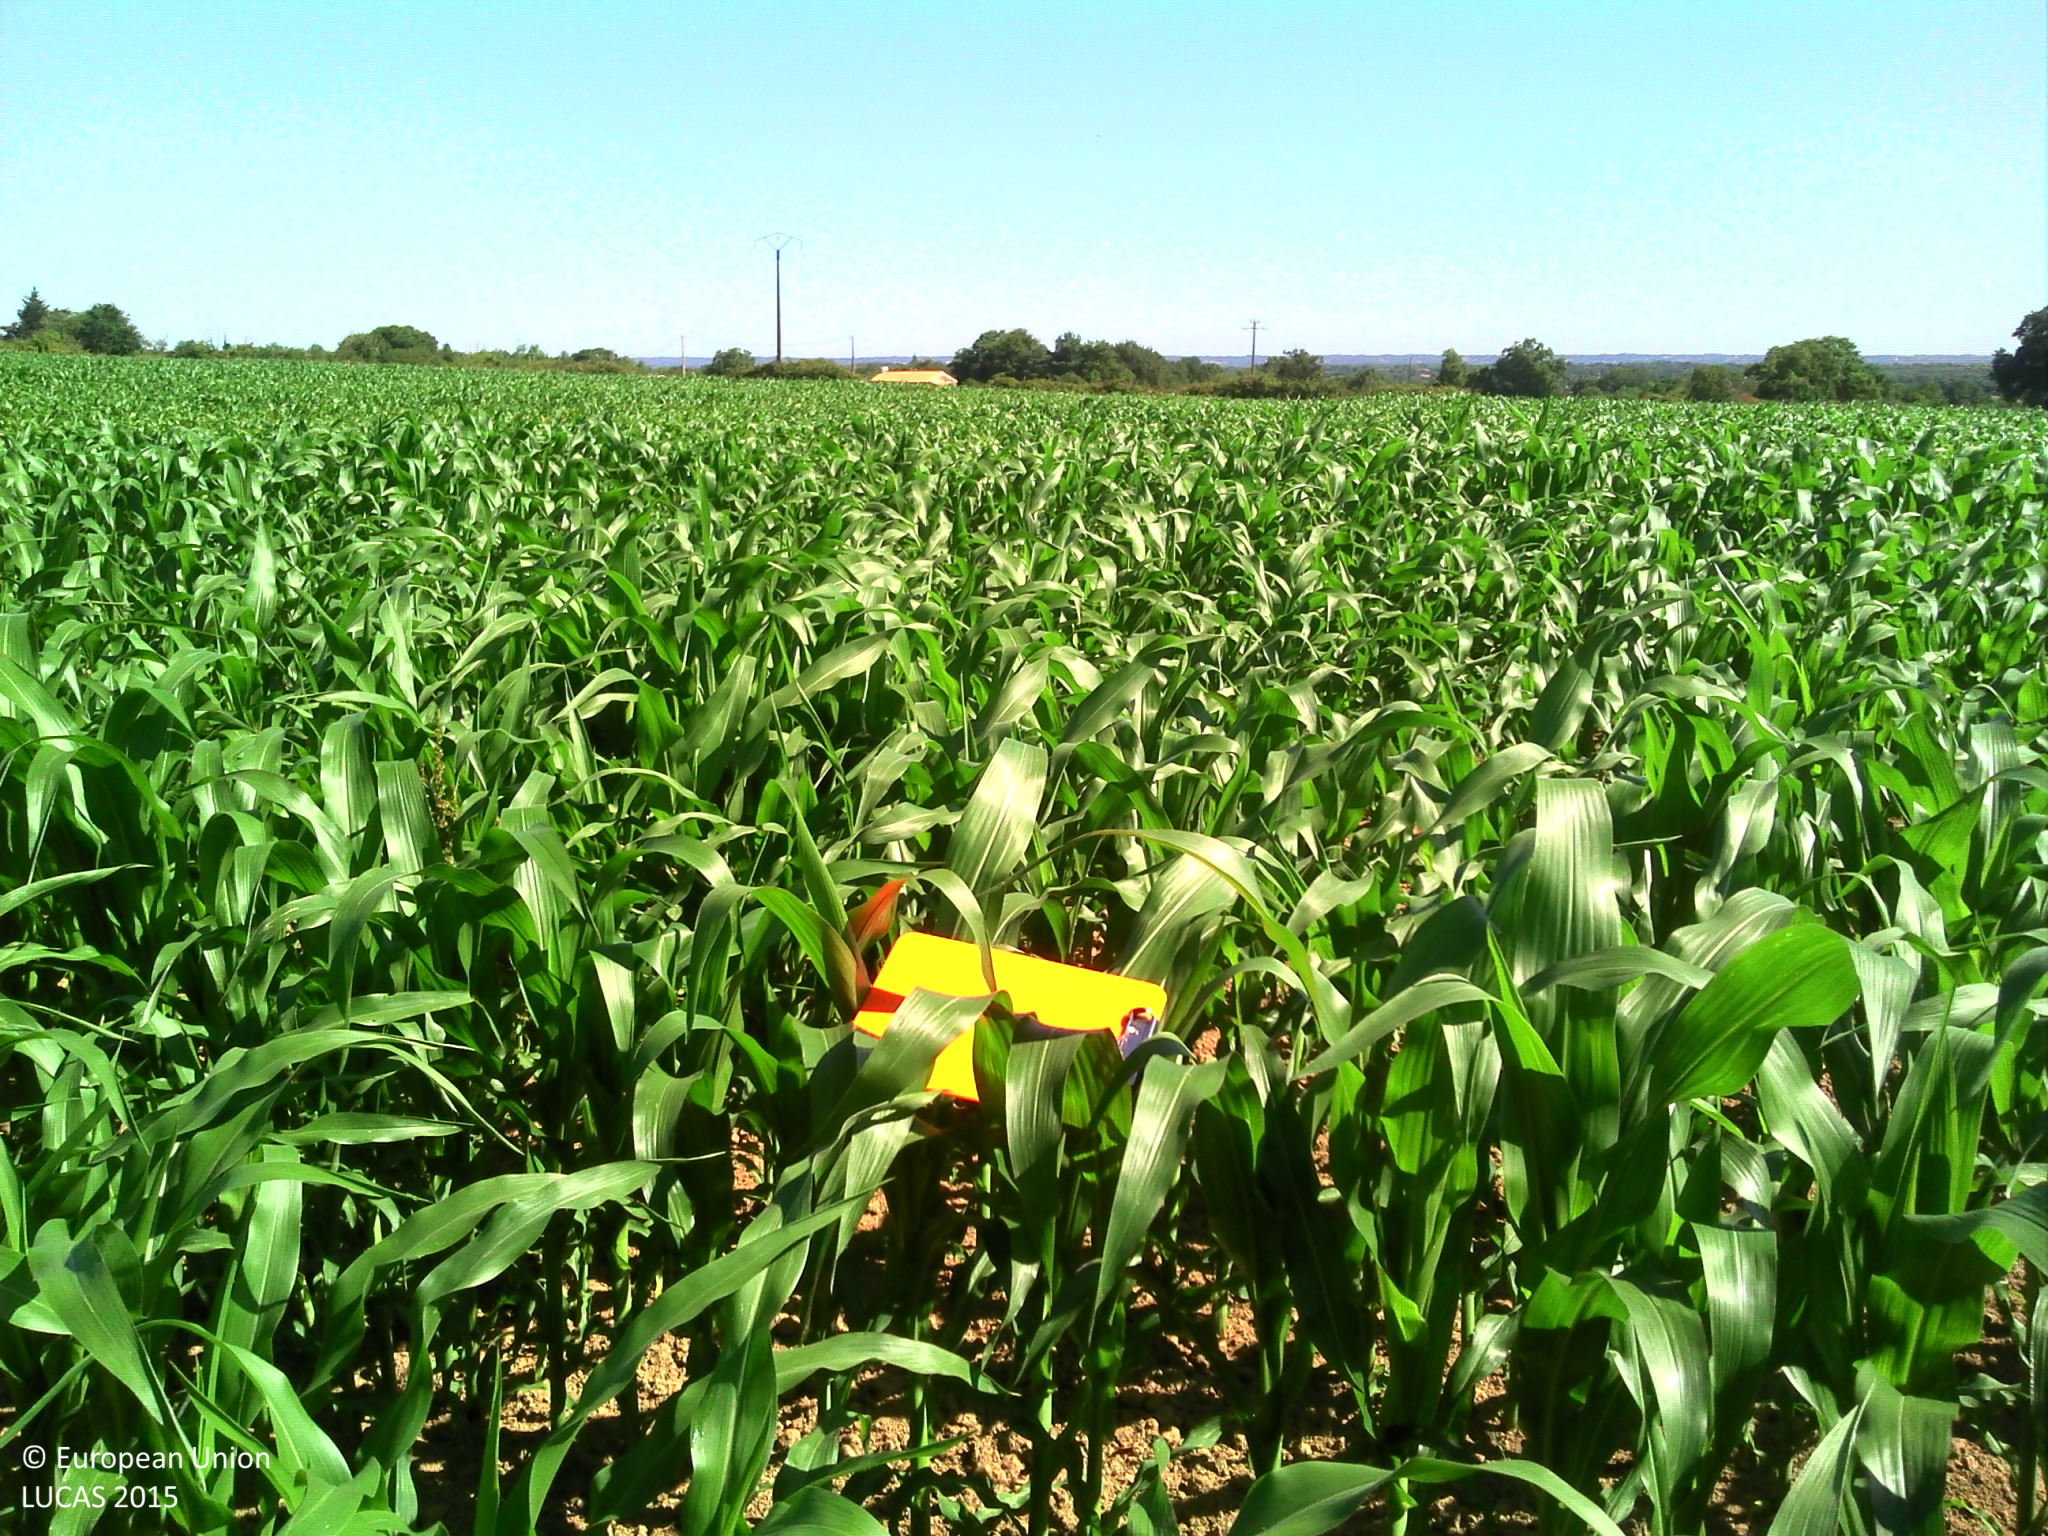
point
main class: Cropland
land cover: Maize
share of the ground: 50 - 75 %
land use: Agriculture (excluding fallow land and kitchen gardens)
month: July
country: FR
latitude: 47.1513
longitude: -1.7958
